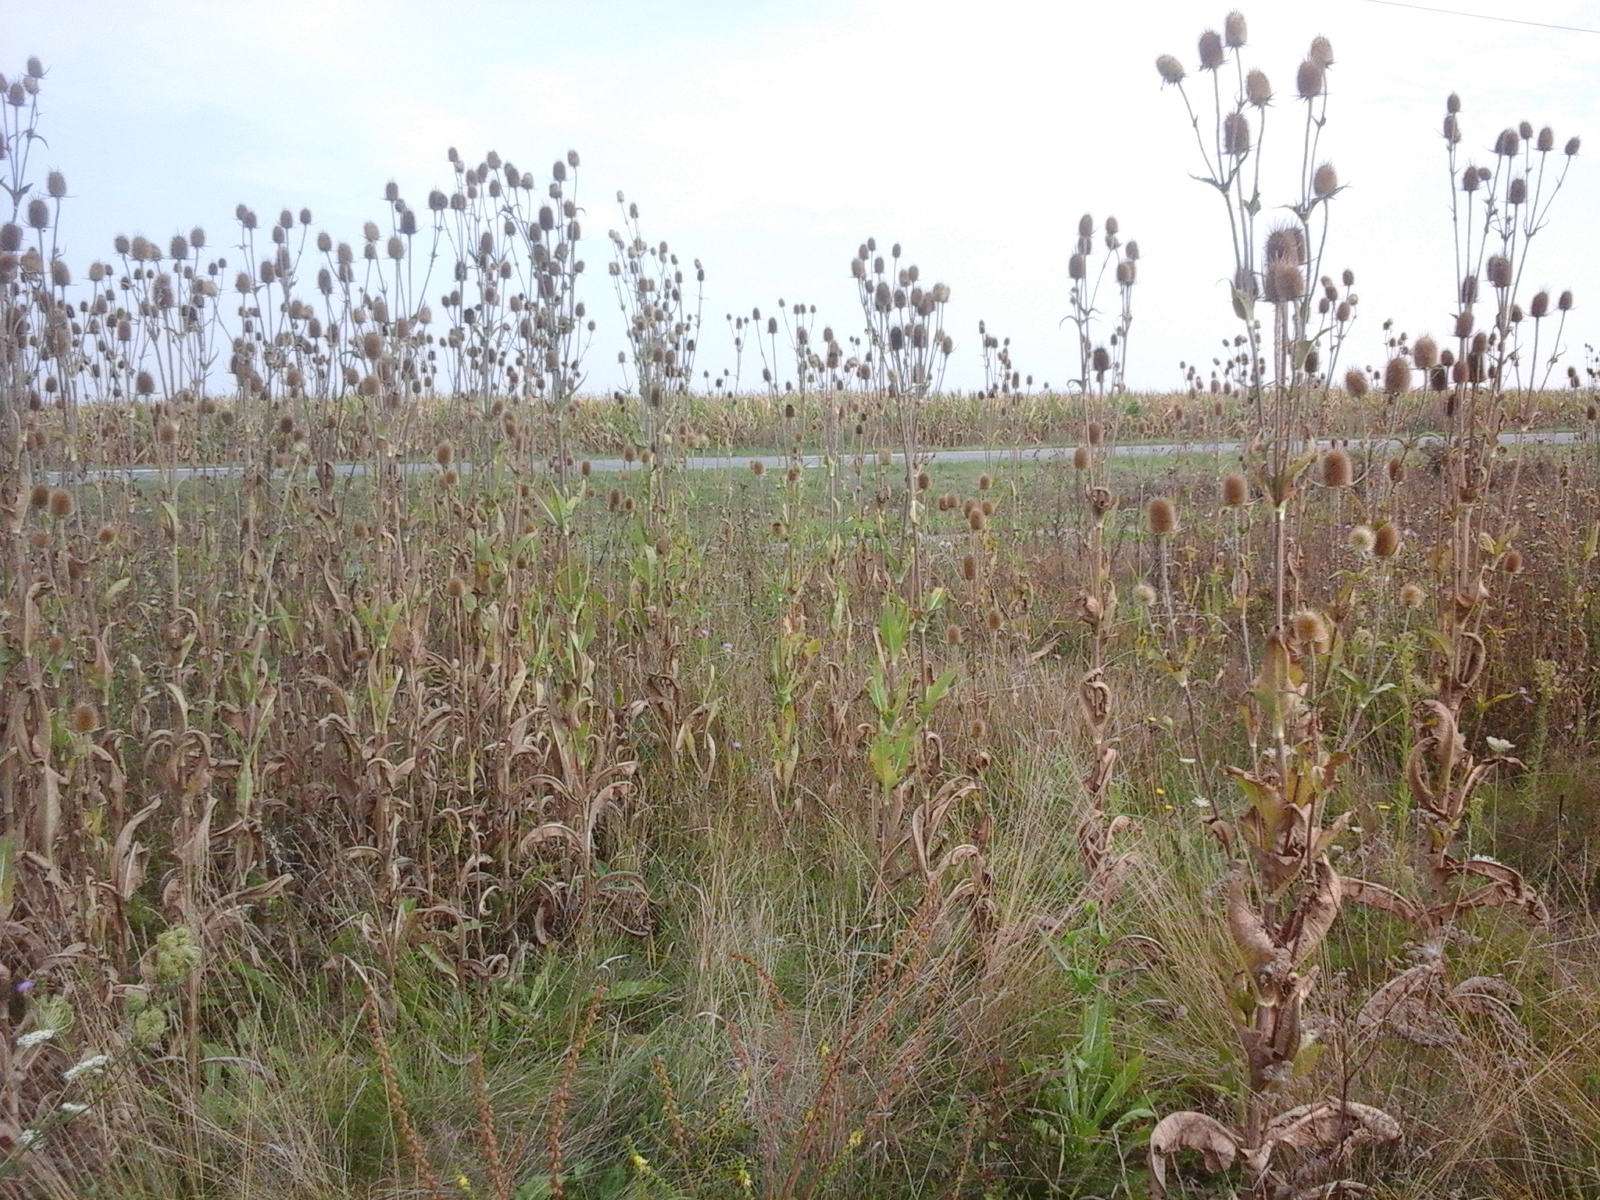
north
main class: Cropland
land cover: Maize
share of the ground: > 75 %
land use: Agriculture (excluding fallow land and kitchen gardens)
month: August
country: RO
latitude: 46.7899
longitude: 21.6079
